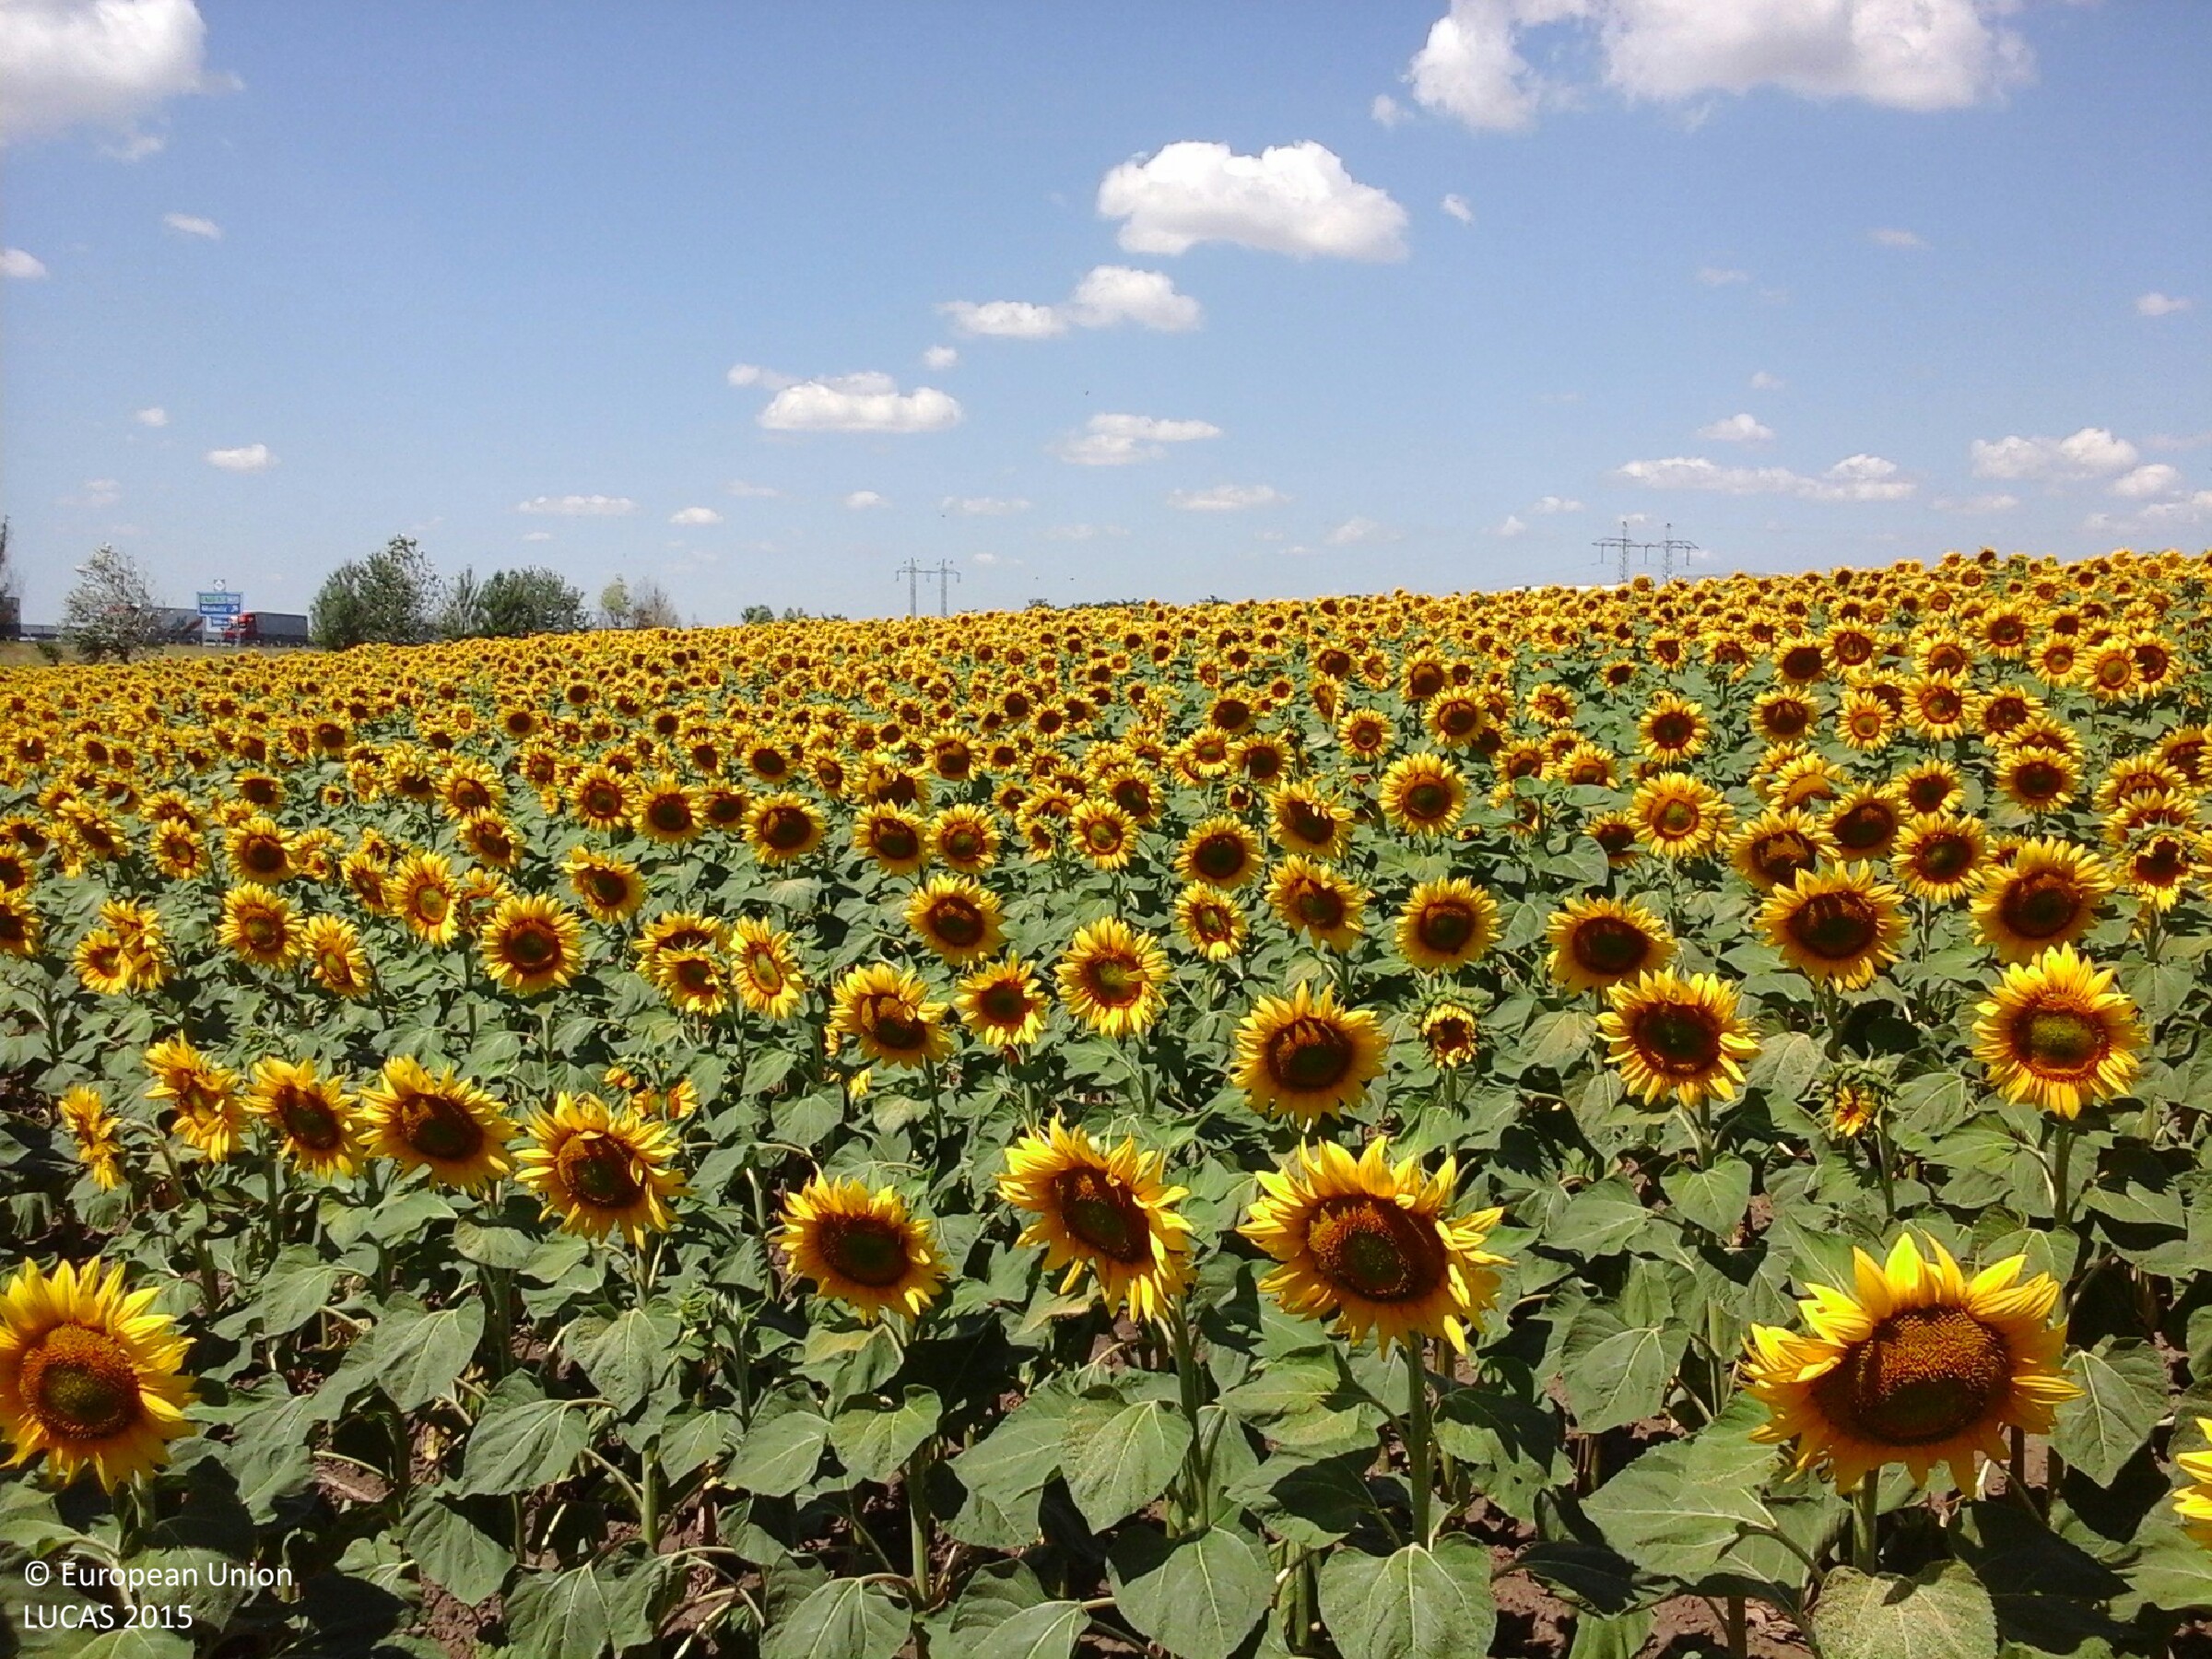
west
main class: Cropland
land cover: Sunflower
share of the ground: > 75 %
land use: Agriculture (excluding fallow land and kitchen gardens)
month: July
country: HU
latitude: 47.8855
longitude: 20.8555
